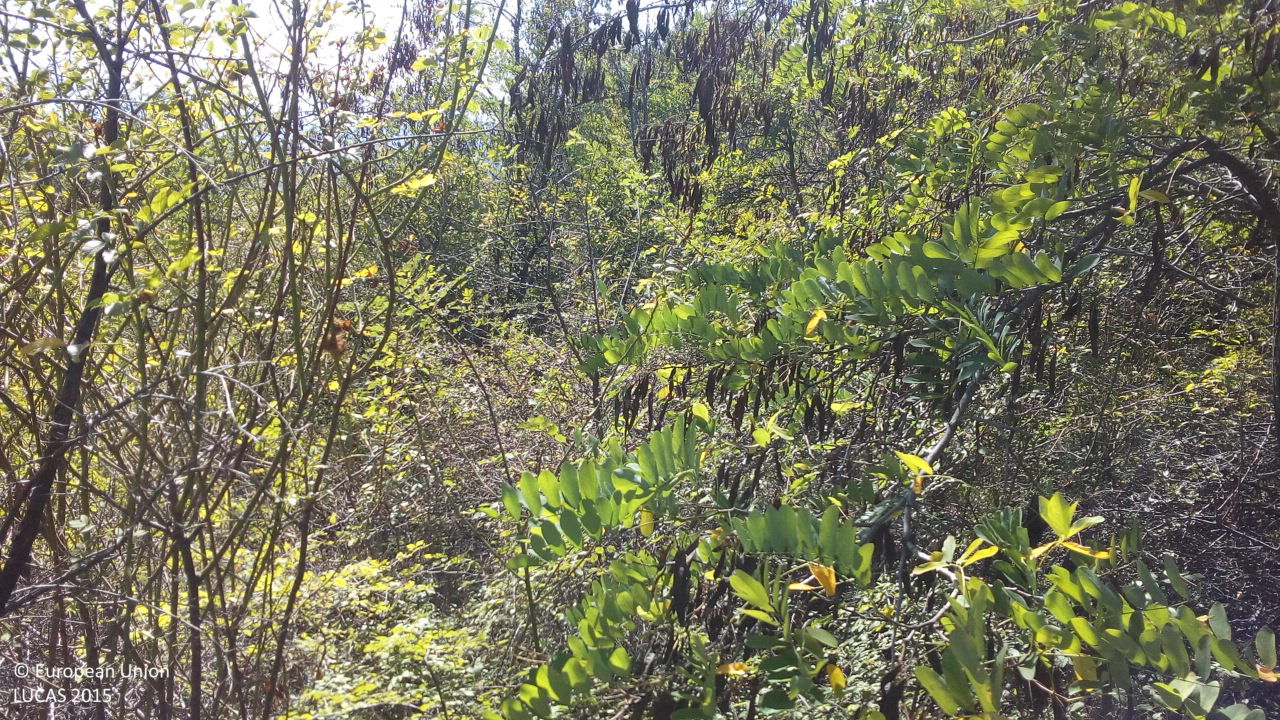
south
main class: Woodland
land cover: Broadleaved woodland
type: thermophilous deciduous forest
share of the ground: > 75 %
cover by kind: broadleaved forest trees 95 %, unconsolidated bare surface 5 %
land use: Forestry
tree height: < 5 m
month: October
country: BG
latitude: 42.0545
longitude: 22.9639
